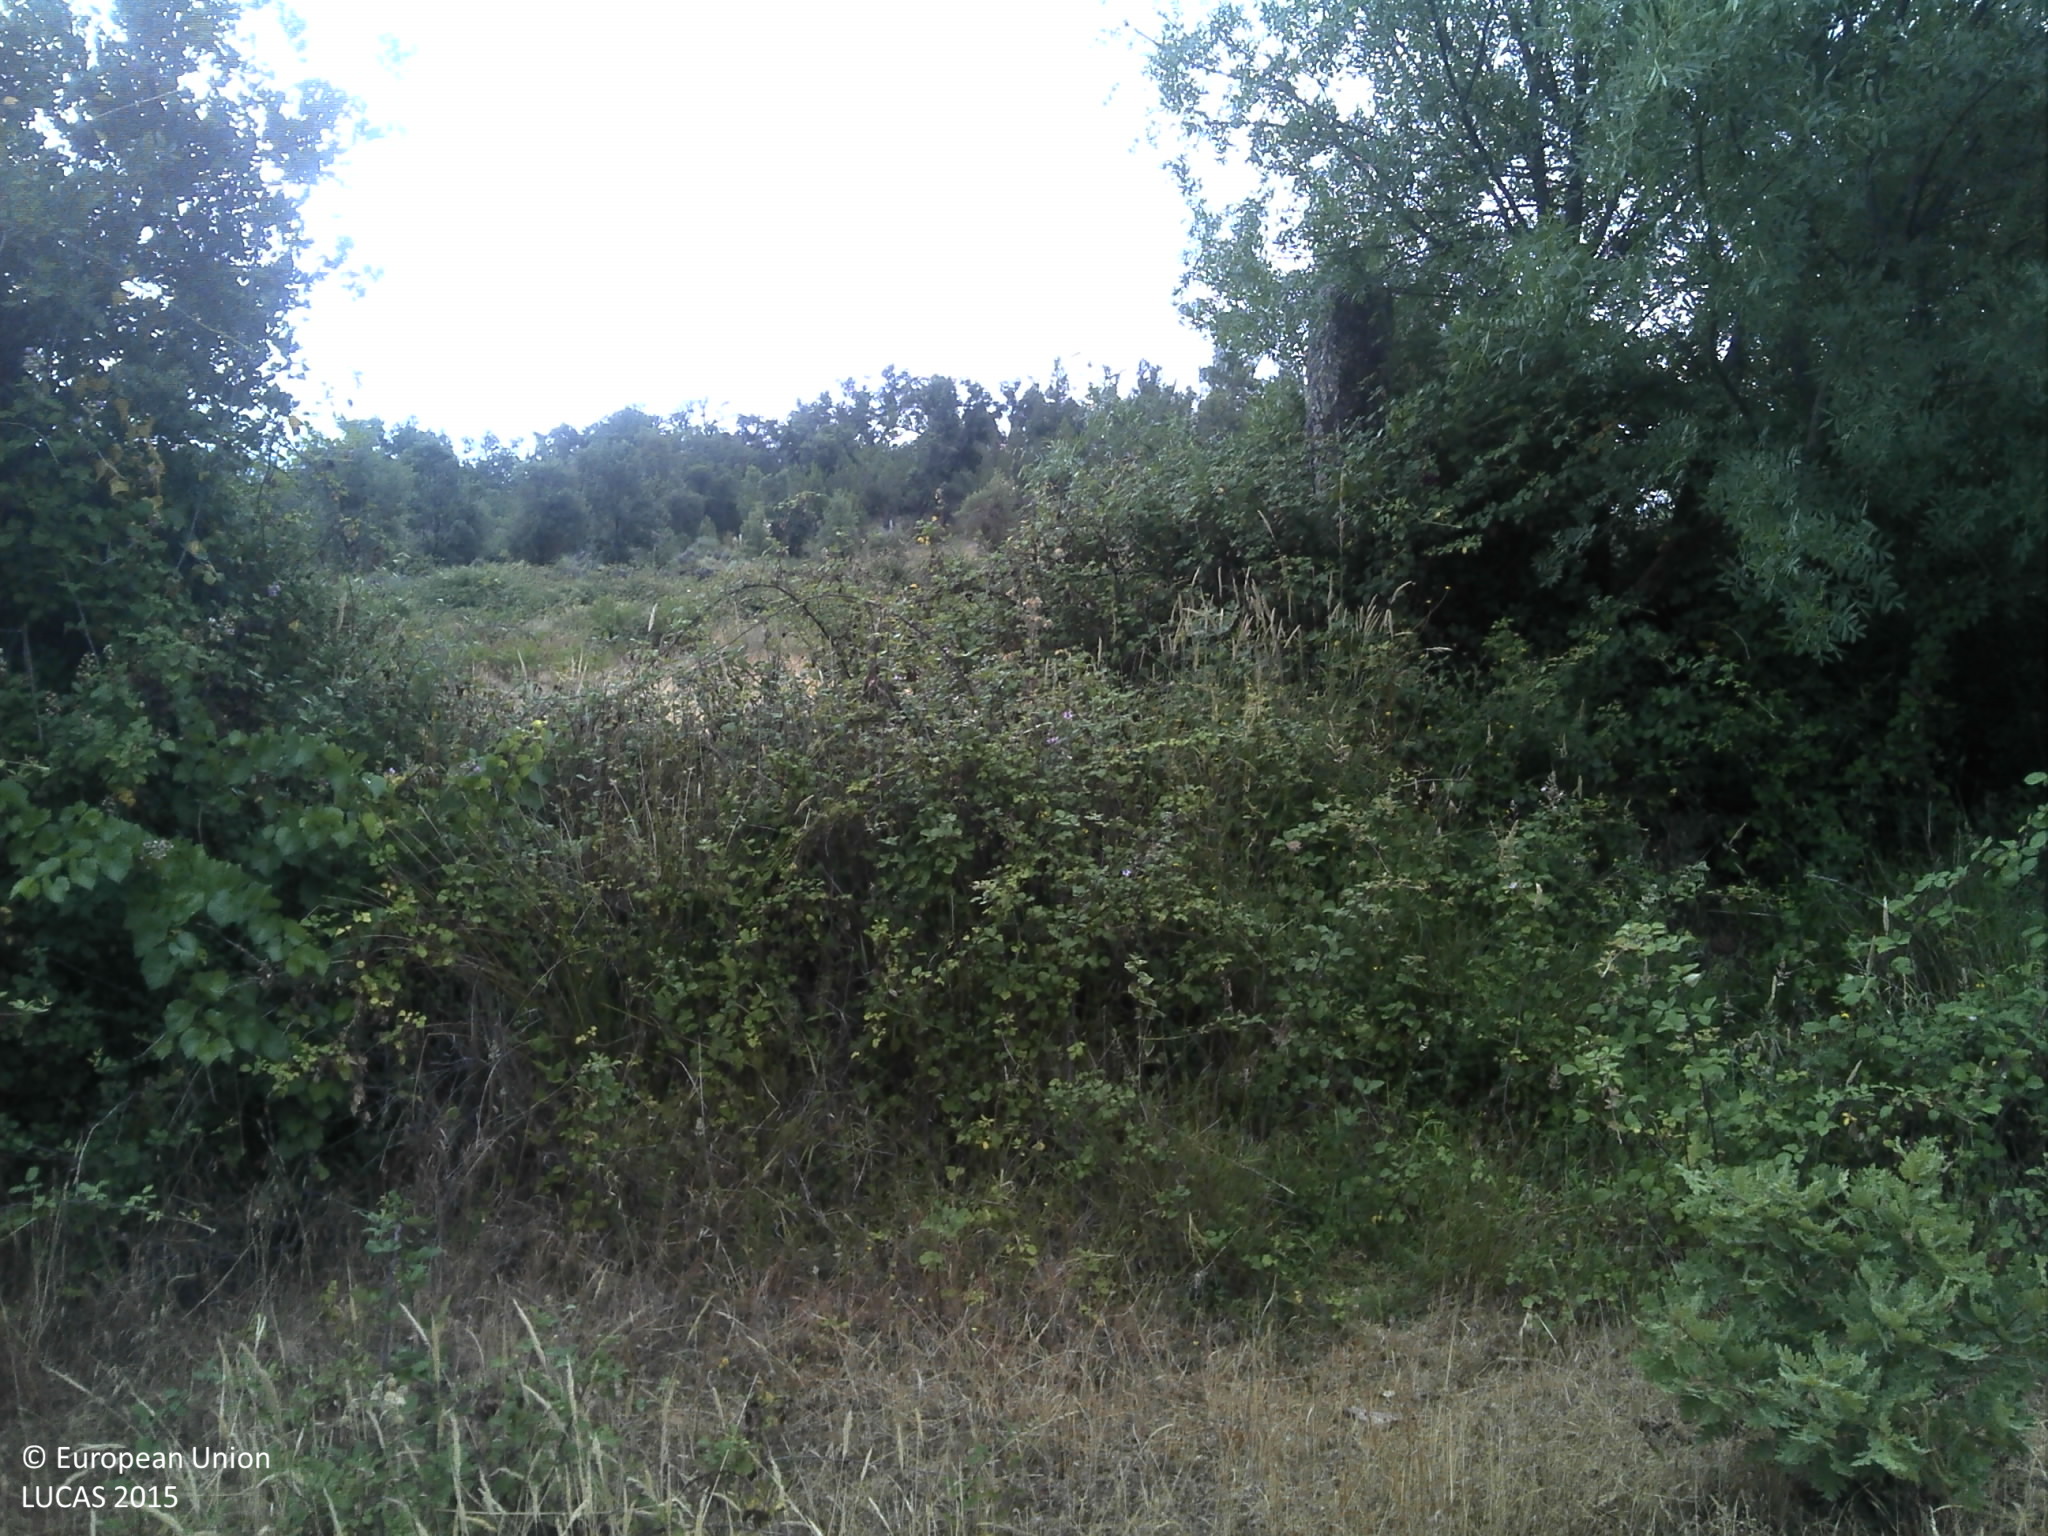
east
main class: Grassland
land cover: Grassland without tree/shrub cover
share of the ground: 50 - 75 %
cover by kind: herbaceous plants 60 %, unconsolidated bare surface 40 %
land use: Agriculture (excluding fallow land and kitchen gardens)
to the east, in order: Grassland without tree/shrub cover; Shruby margins; Grassland without tree/shrub cover; Dry stone walls; Abandoned hedges; Grassland with sparse tree/shrub cover; Dry stone walls; Shrubland with sparse tree cover; Grassland without tree/shrub cover
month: June
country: PT
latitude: 40.1553
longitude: -7.2029
